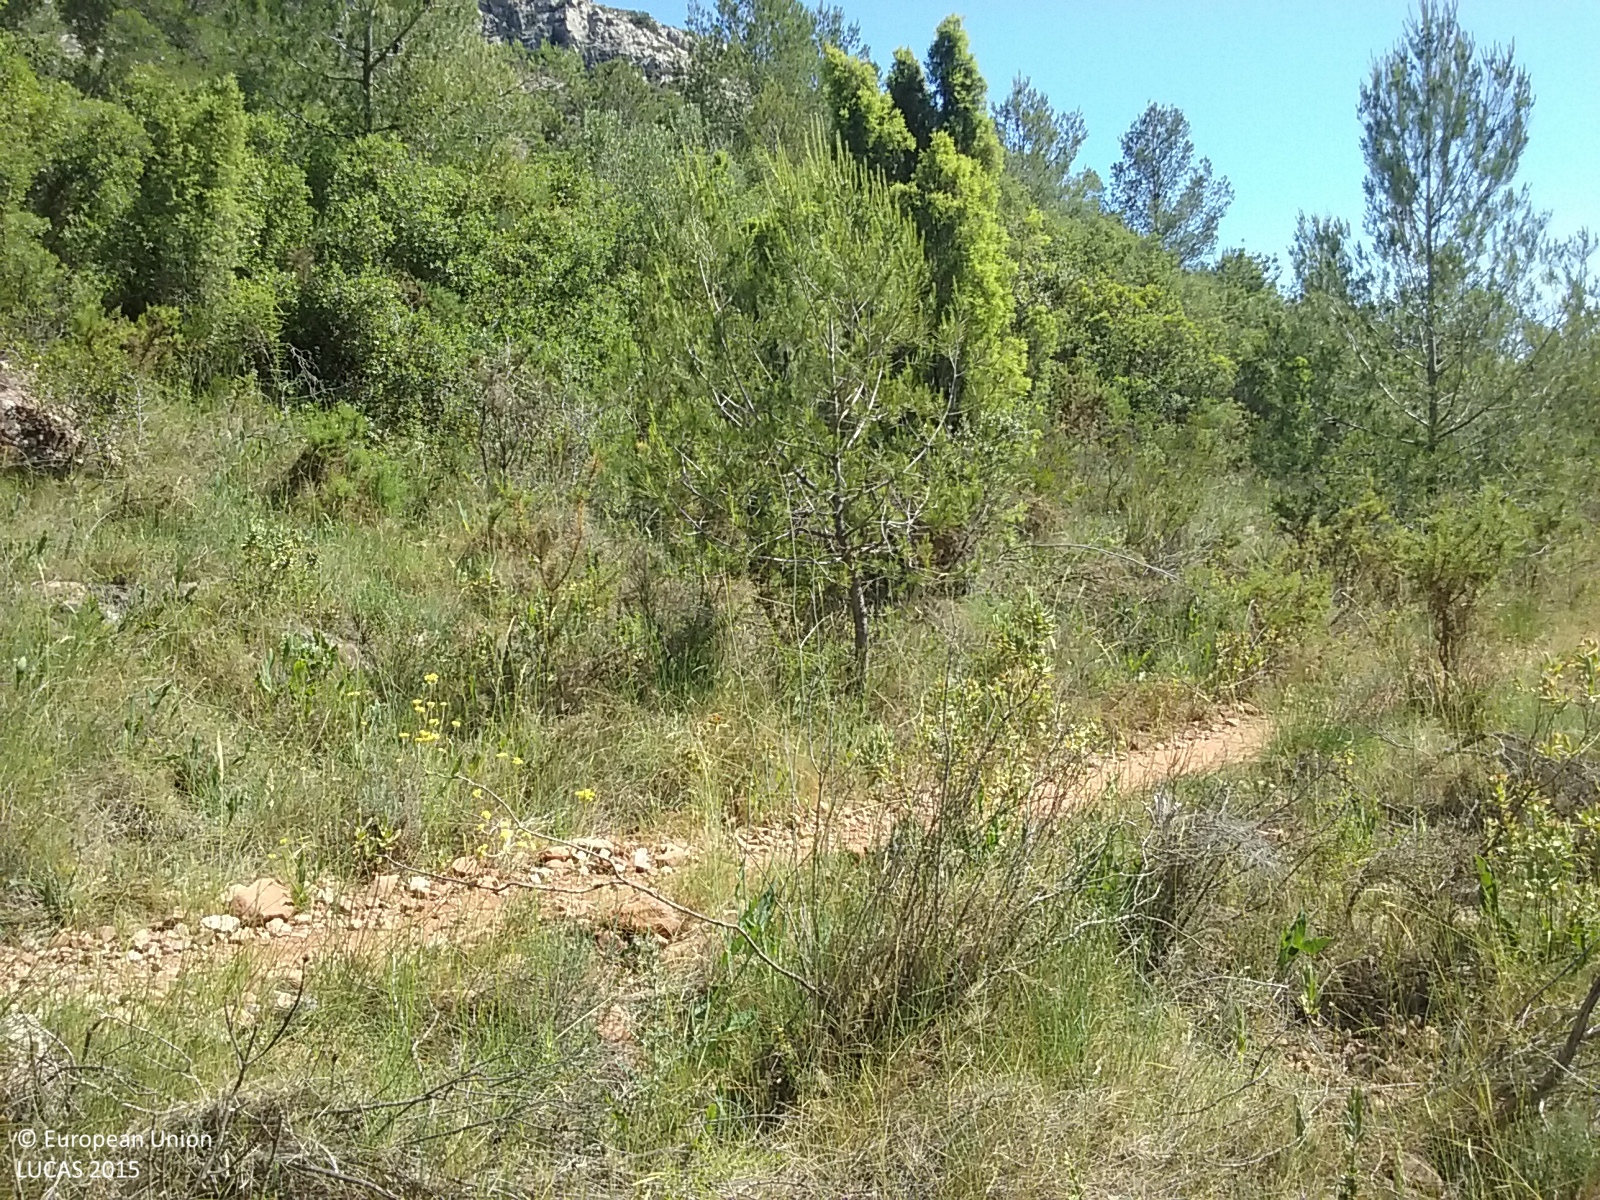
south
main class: Woodland
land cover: Pine dominated mixed woodland
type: coniferous forest of the mediterranean region
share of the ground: 50 - 75 %
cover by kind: coniferous forest trees 65 %, broadleaved forest trees 25 %, shrubs 10 %
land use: Semi-natural and natural areas not in use
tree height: > 5 m
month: June
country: ES
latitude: 40.0467
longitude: 0.0004
